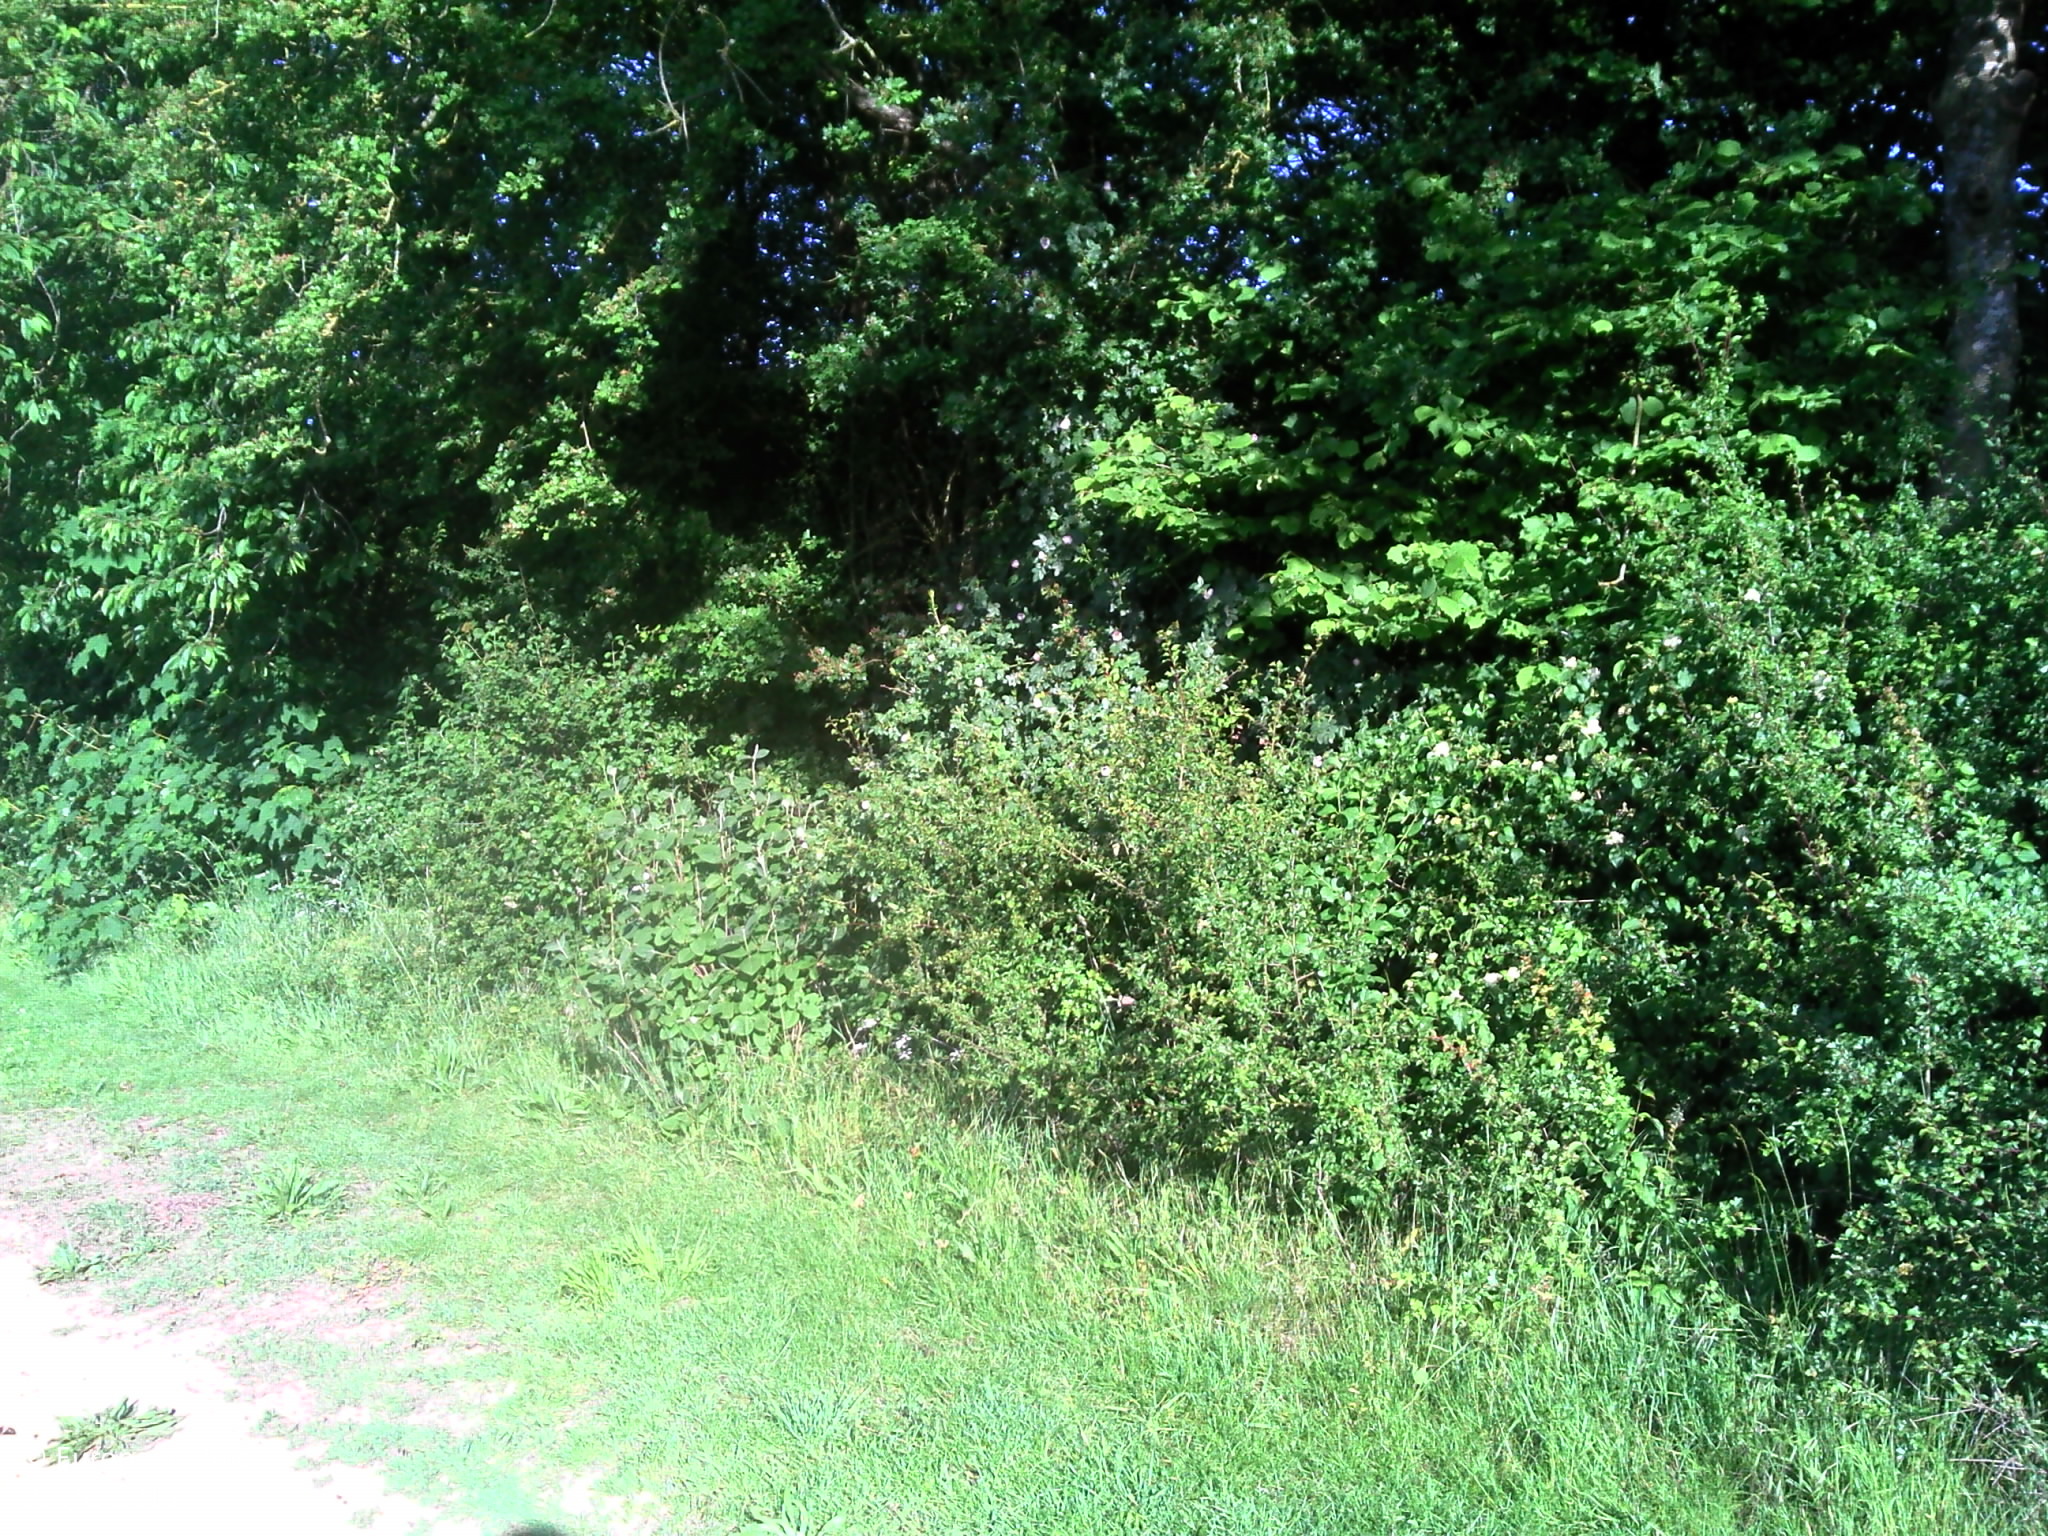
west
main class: Cropland
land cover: Rape and turnip rape
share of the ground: > 75 %
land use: Agriculture (excluding fallow land and kitchen gardens)
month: June
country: FR
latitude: 49.8633
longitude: 2.2094
